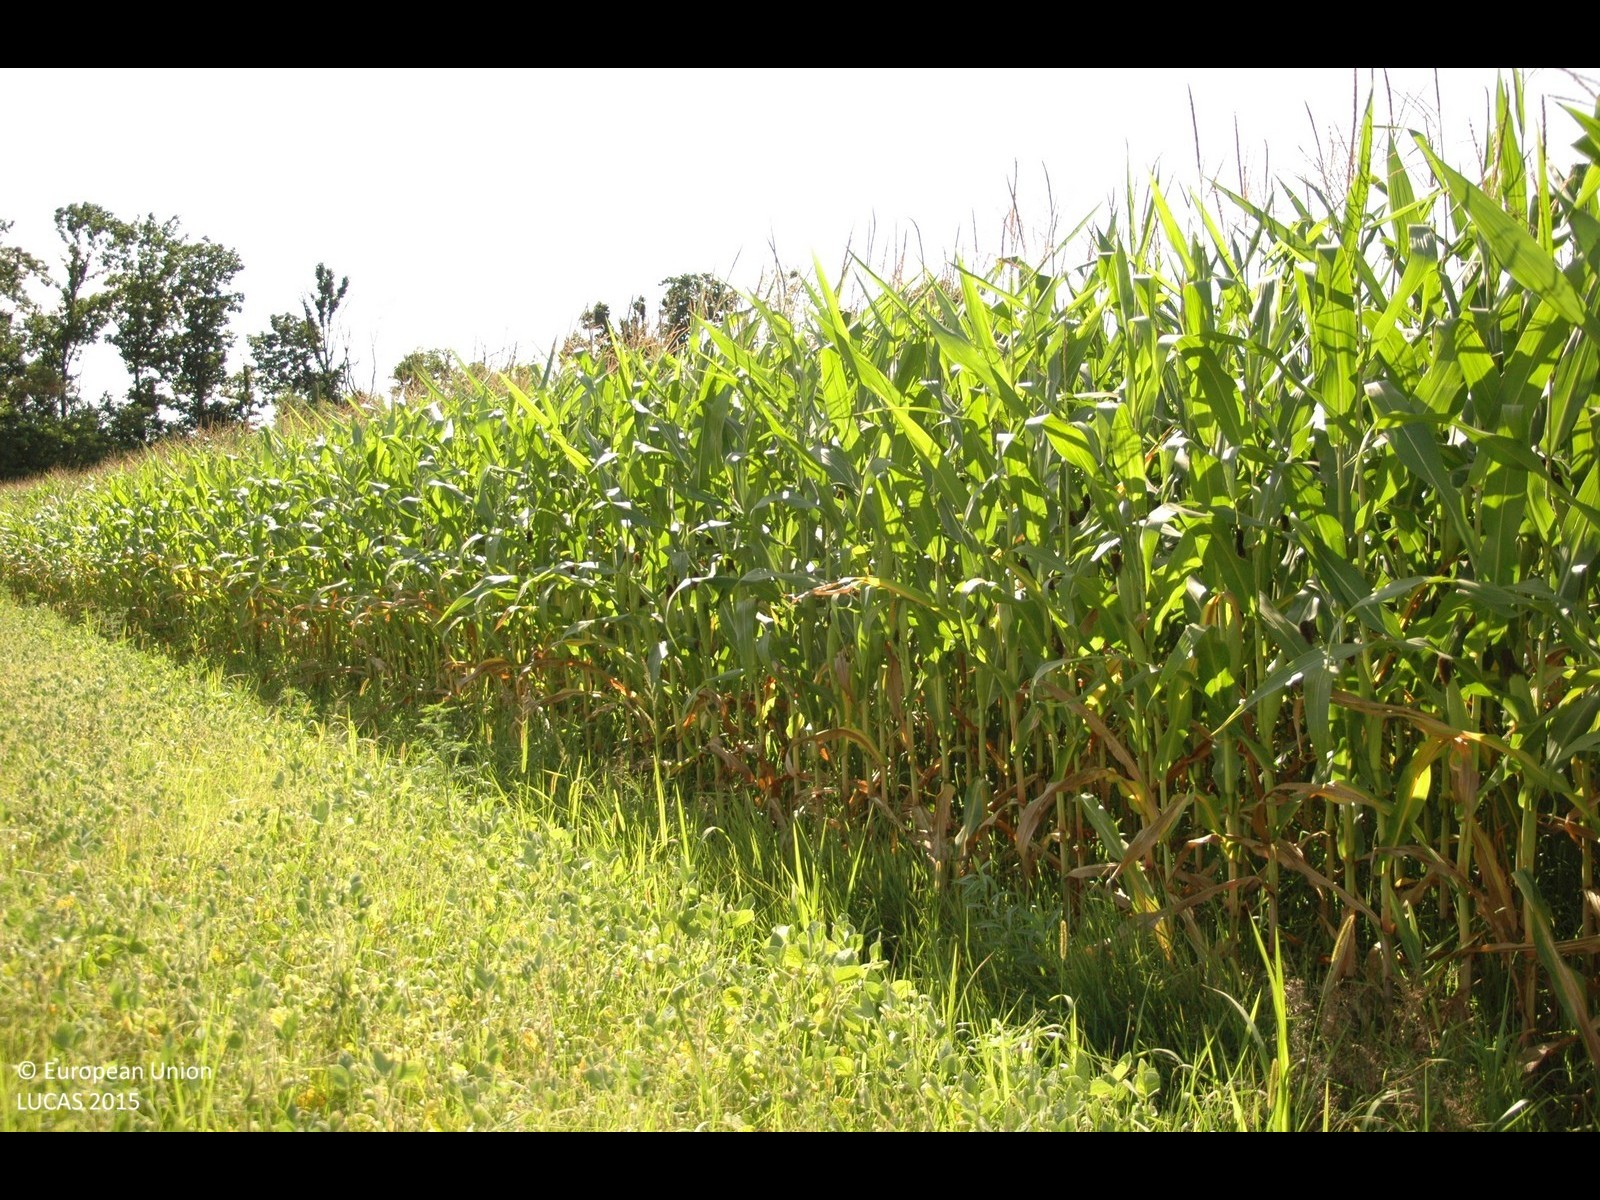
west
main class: Cropland
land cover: Soya
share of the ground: > 75 %
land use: Agriculture (excluding fallow land and kitchen gardens)
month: July
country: HR
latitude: 46.2132
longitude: 16.7025
